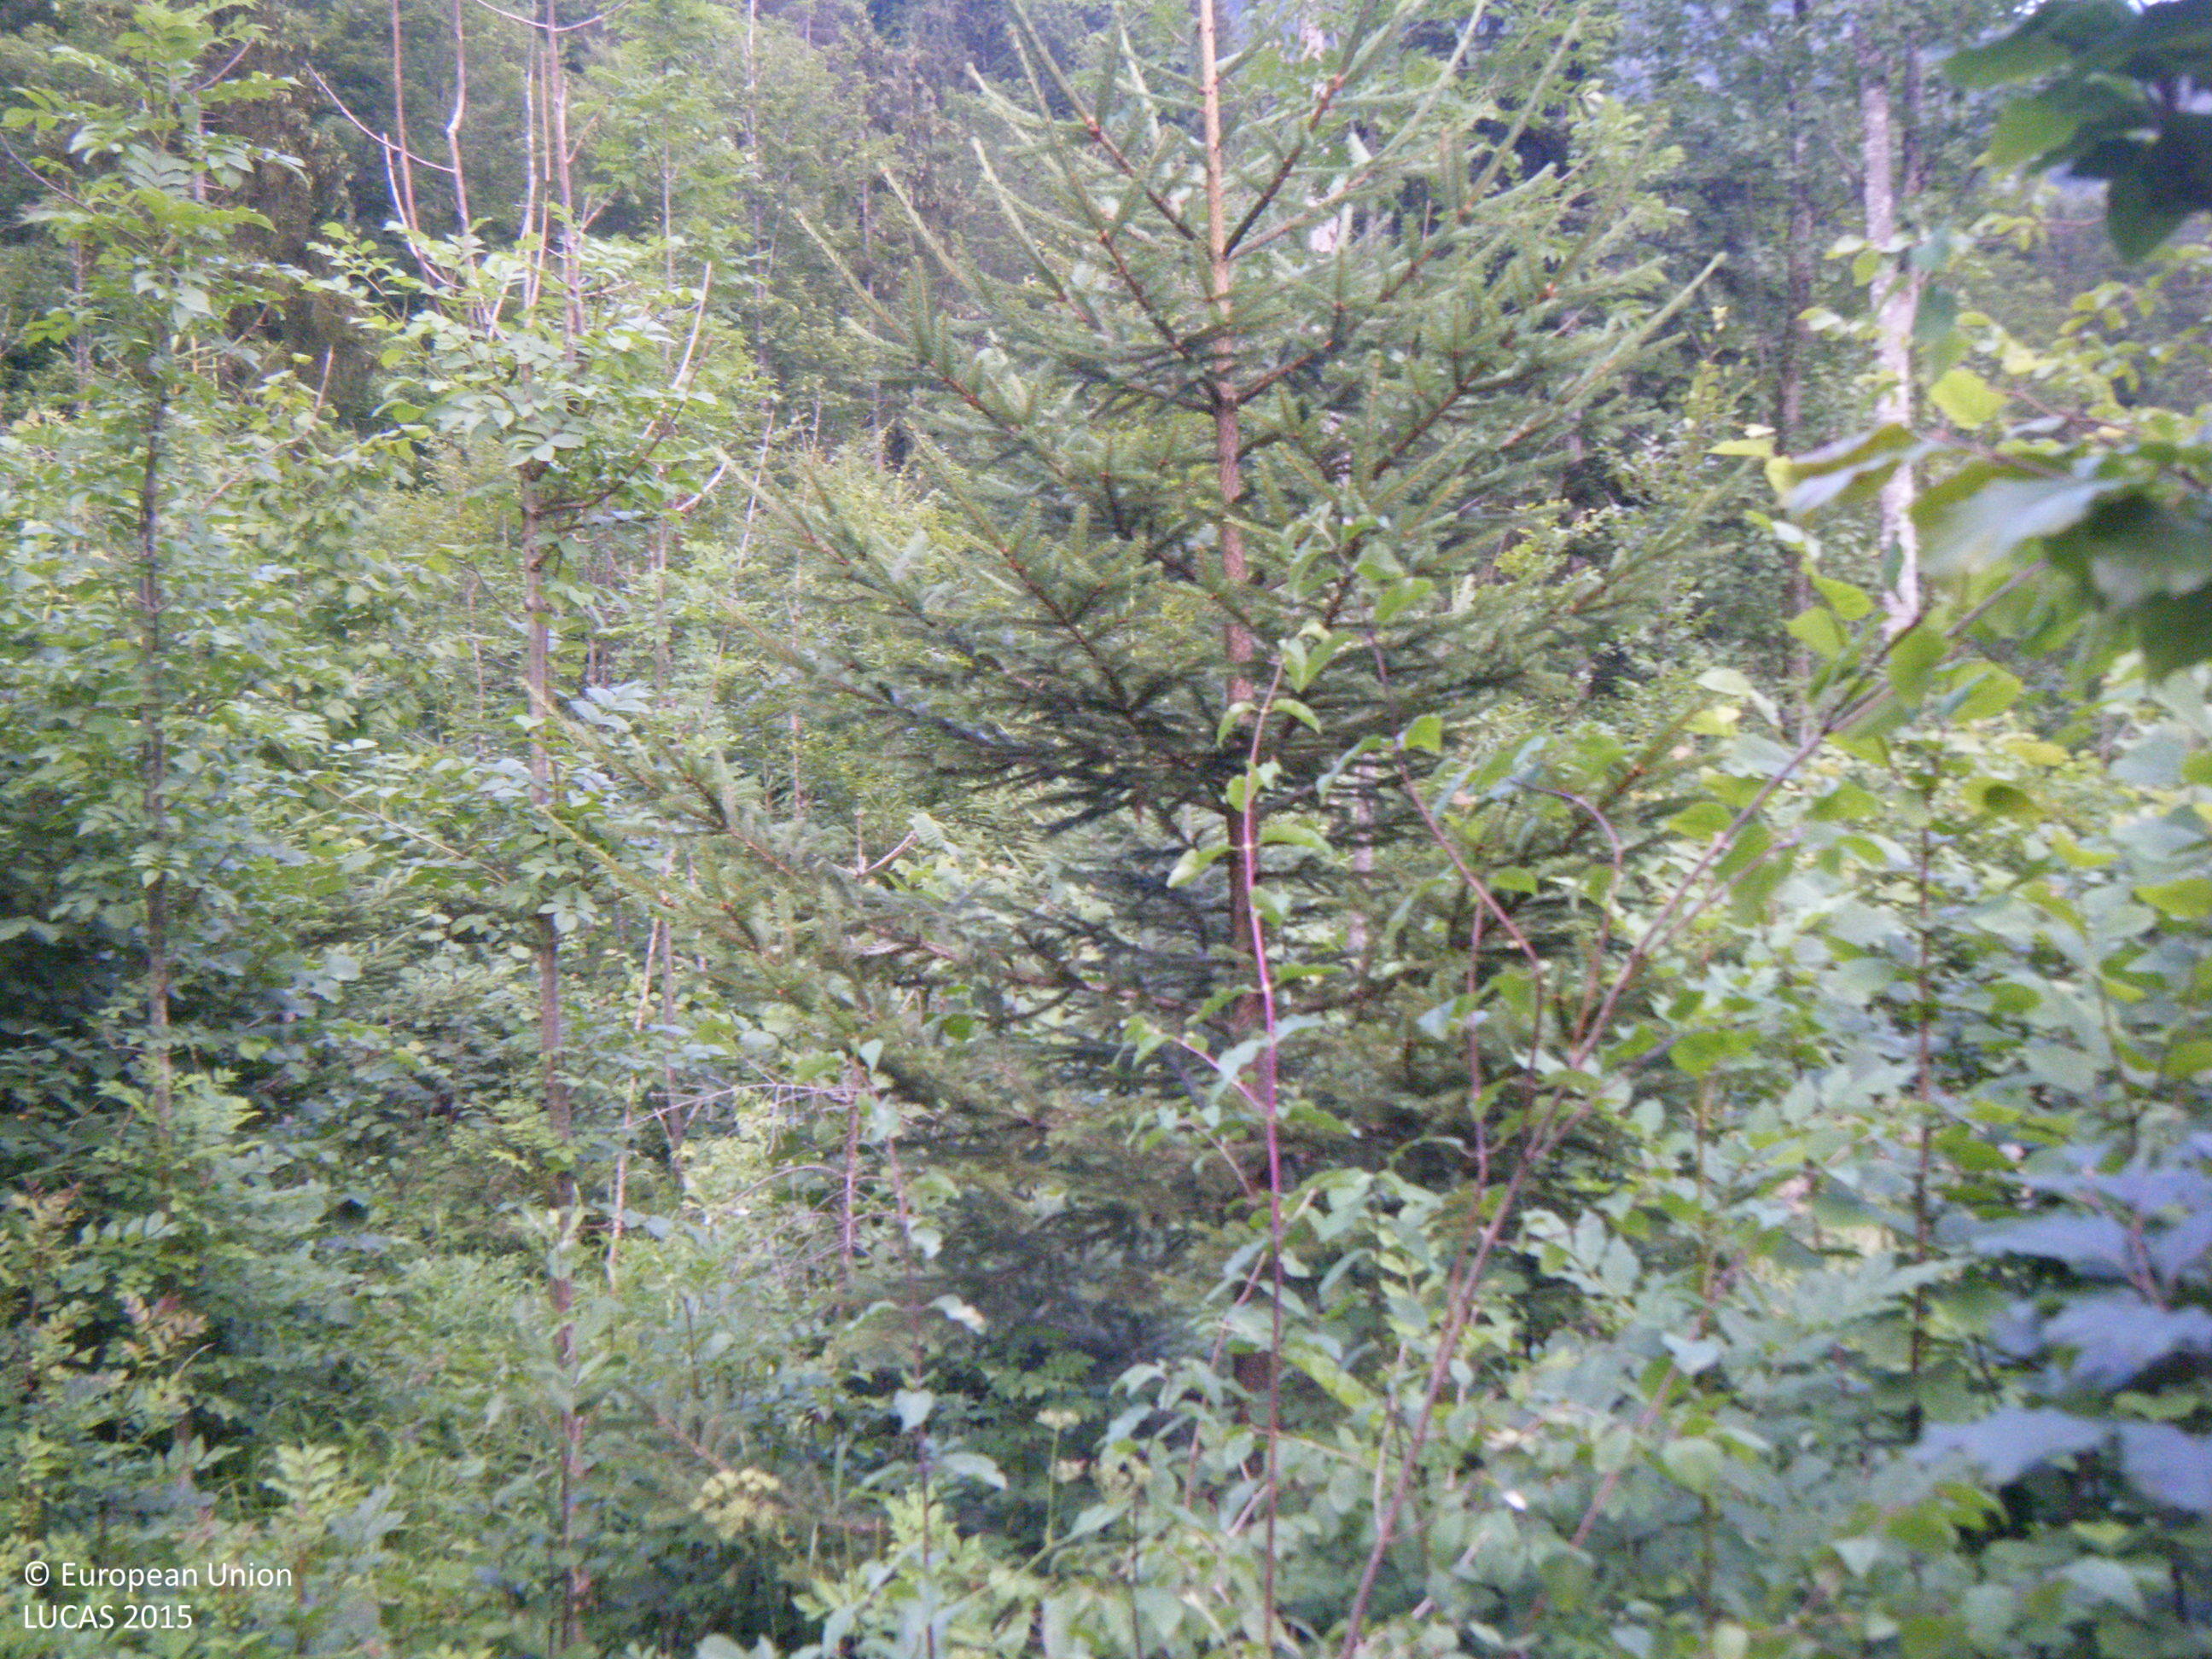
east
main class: Woodland
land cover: Spruce dominated mixed woodland
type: mesophytic deciduous forest
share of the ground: > 75 %
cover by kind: broadleaved forest trees 50 %, coniferous forest trees 25 %, shrubs 15 %, herbaceous plants 10 %
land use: Forestry
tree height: < 5 m
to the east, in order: Spruce dominated mixed woodland; Tracks; Spruce dominated mixed woodland; Rock outcrops; Spruce dominated mixed woodland; Broadleaved woodland; Rock outcrops; Broadleaved woodland; Ditches and canals; Broadleaved woodland; Rocks and stones; Broadleaved woodland
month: July
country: AT
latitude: 47.7347
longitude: 13.5324
